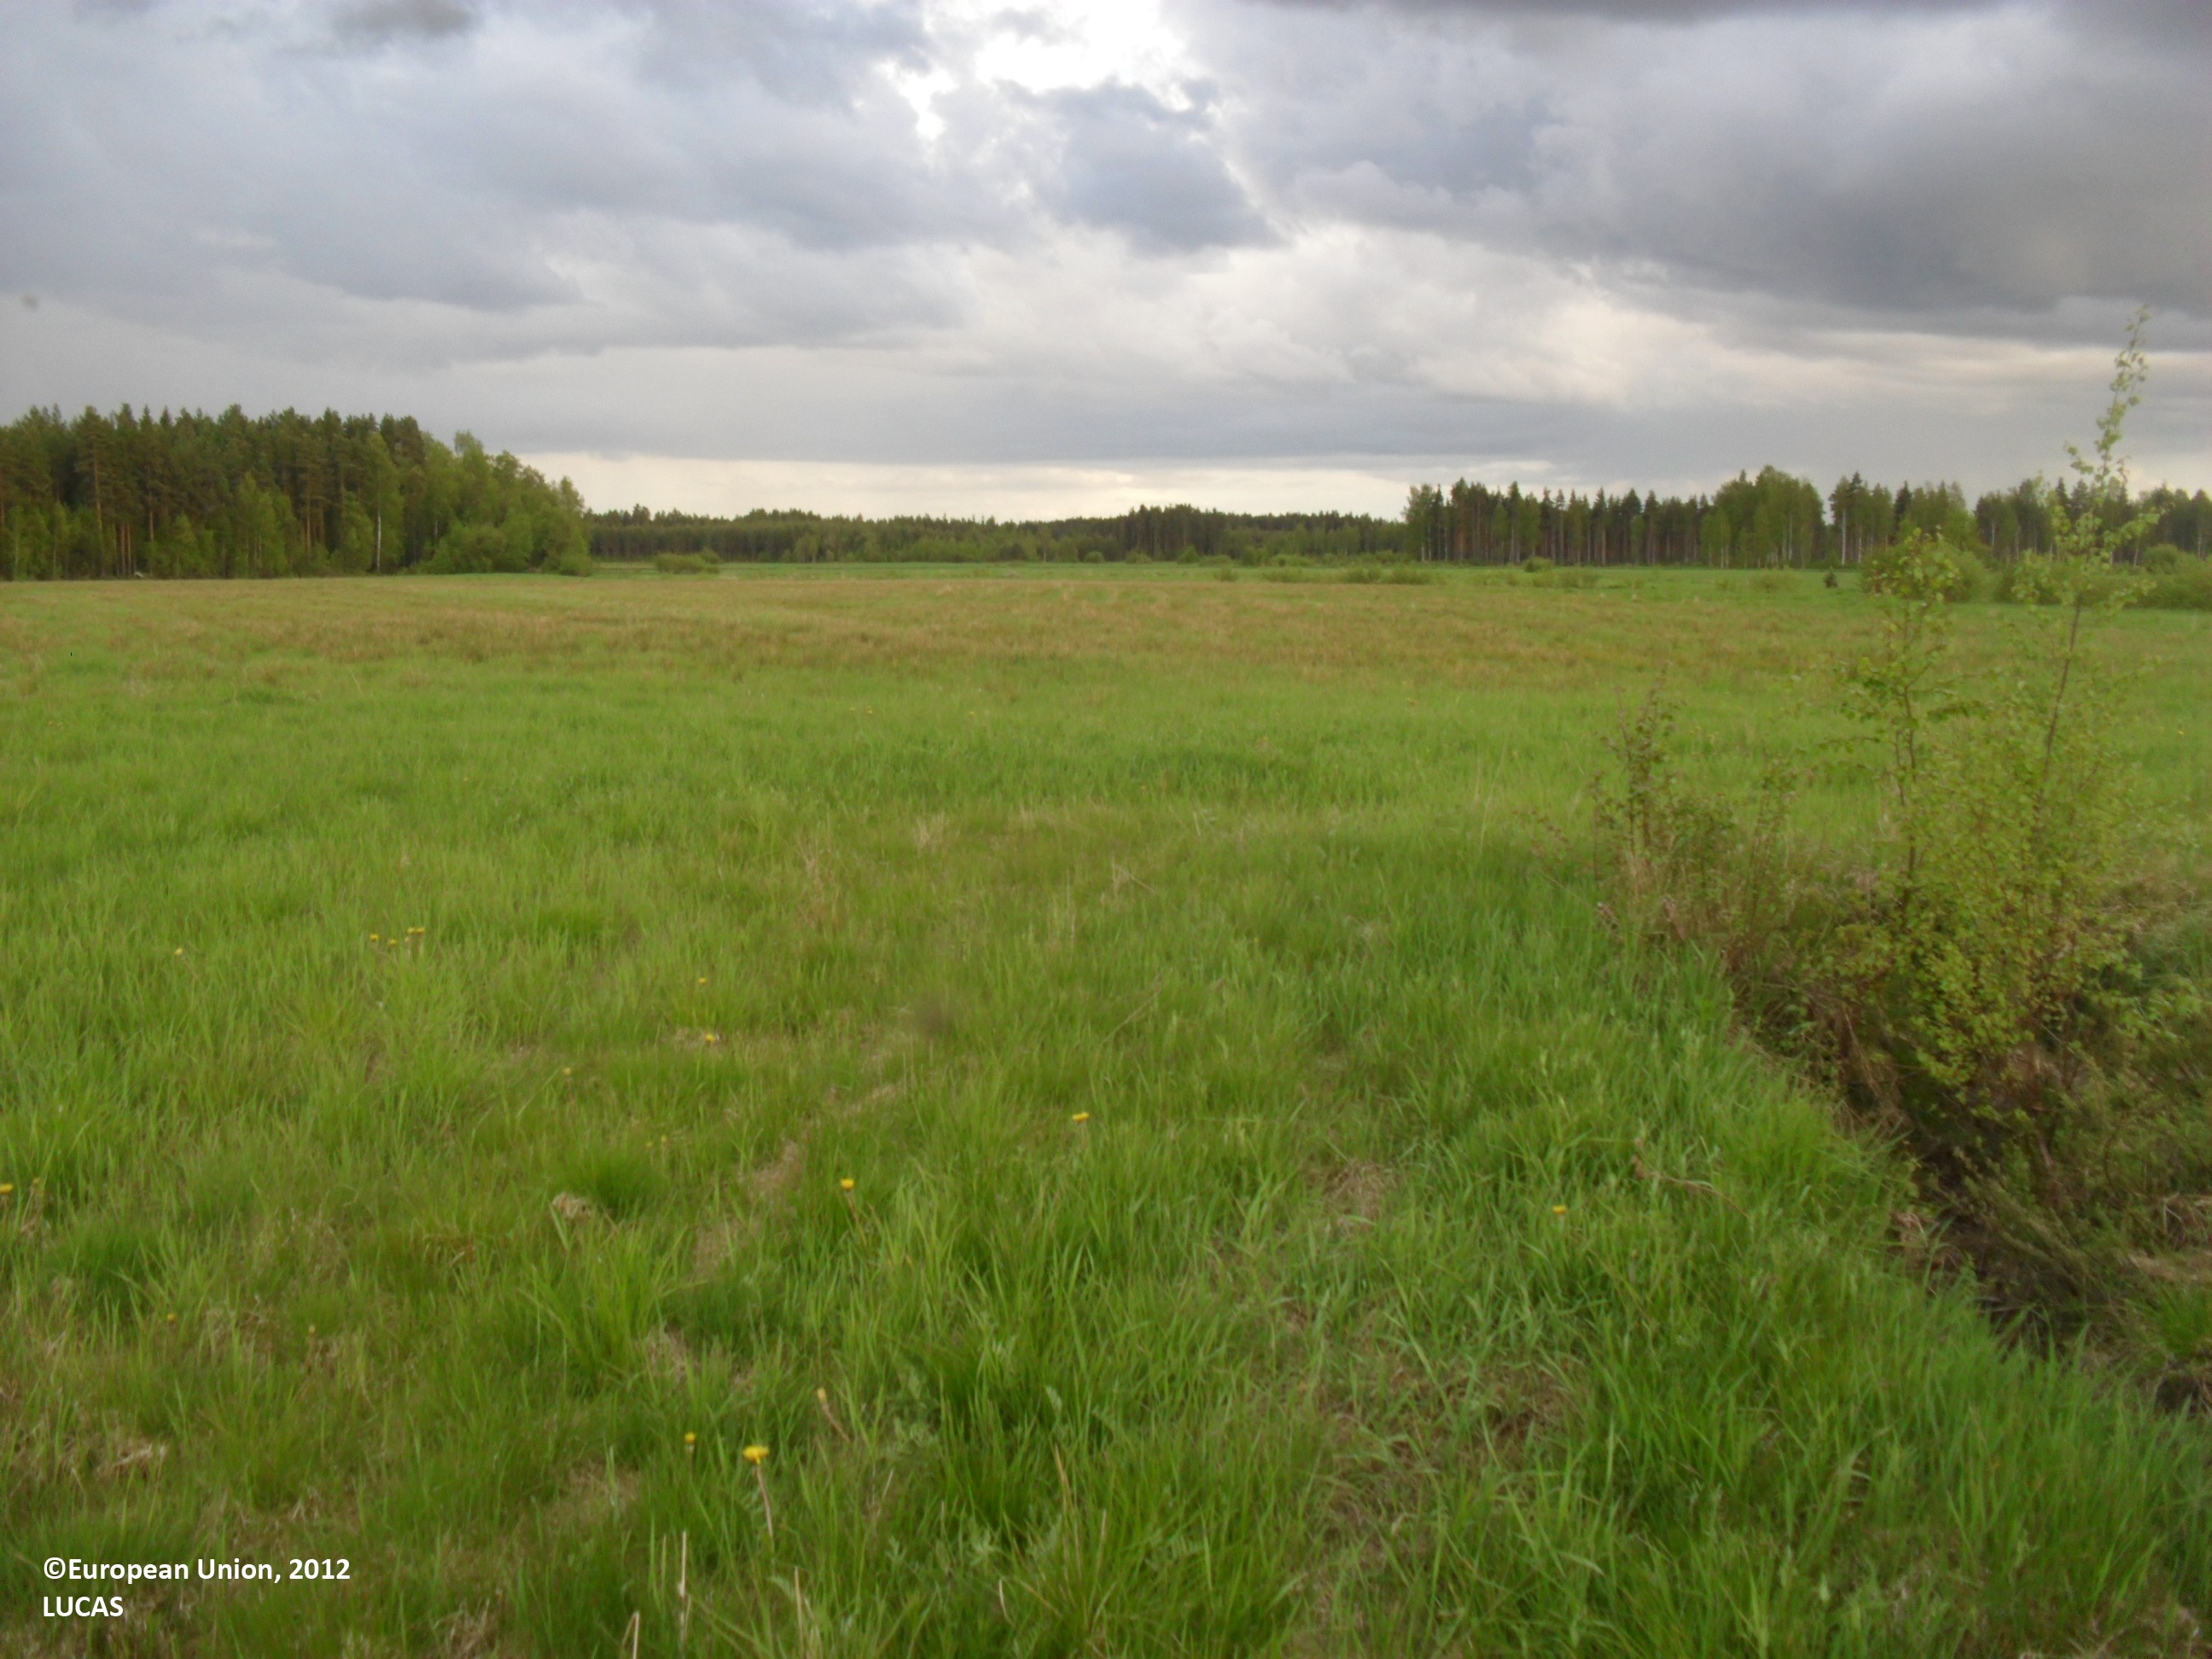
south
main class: Cropland
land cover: Temporary grasslands
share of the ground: > 75 %
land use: Agriculture (excluding fallow land and kitchen gardens)
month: June
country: FI
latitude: 62.9163
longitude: 23.3139
